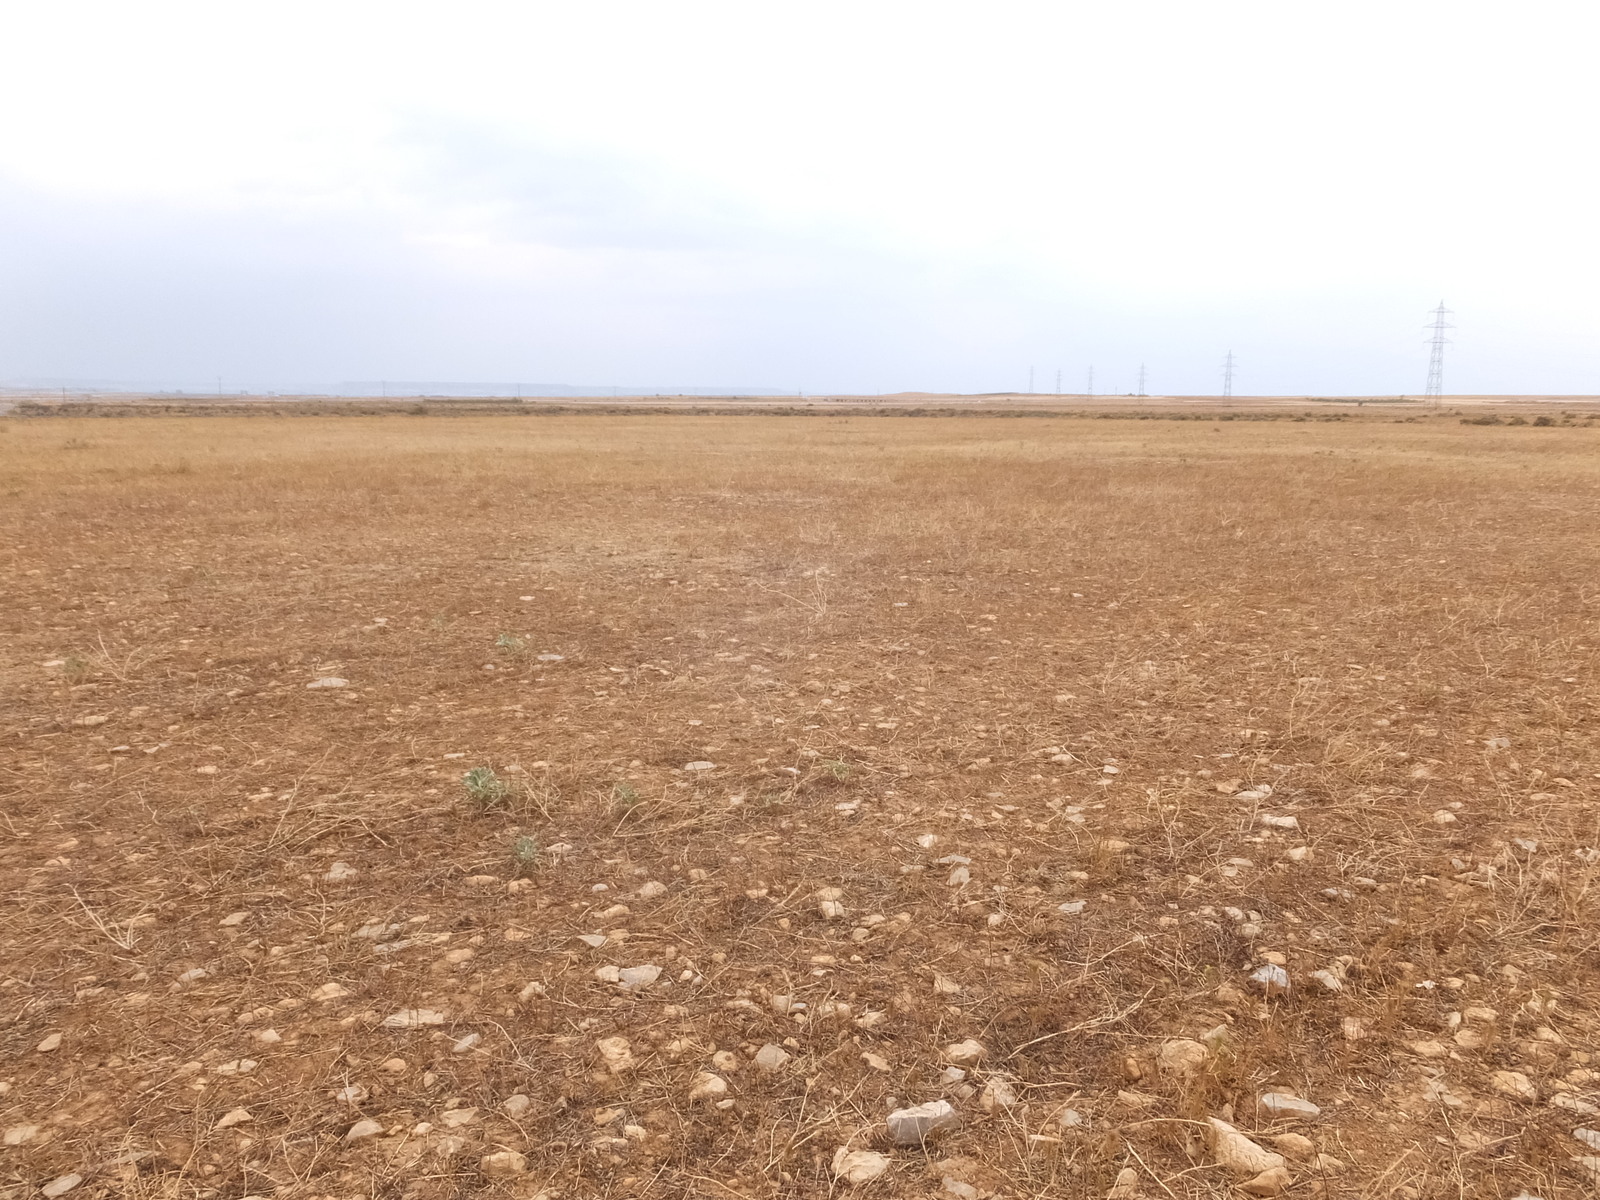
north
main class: Grassland
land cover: Grassland without tree/shrub cover
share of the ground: 25 - 50 %
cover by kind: unconsolidated bare surface 50 %, herbaceous plants 45 %, shrubs 5 %
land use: Agriculture (excluding fallow land and kitchen gardens)
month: June
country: ES
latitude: 41.6946
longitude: 0.0956
